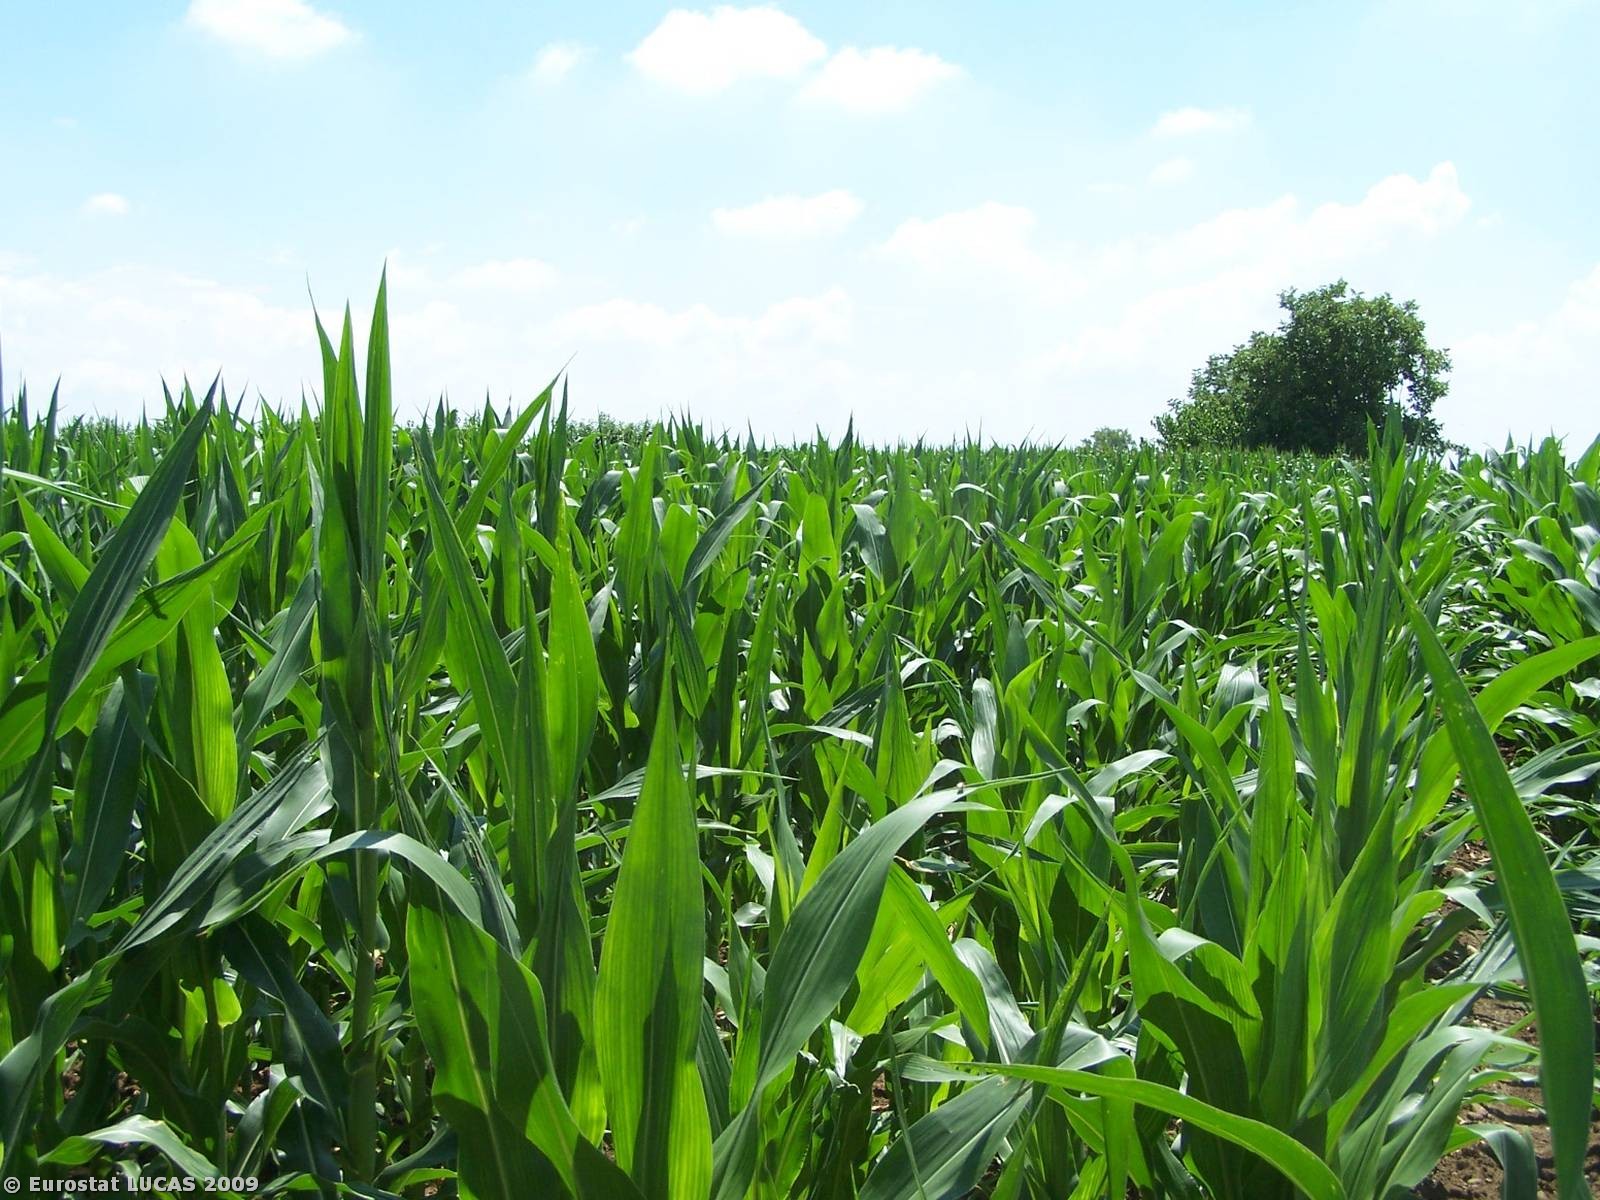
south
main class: Cropland
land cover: Maize
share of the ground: > 75 %
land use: Agriculture (excluding fallow land and kitchen gardens)
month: June
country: IT
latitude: 45.9926
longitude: 13.3401
